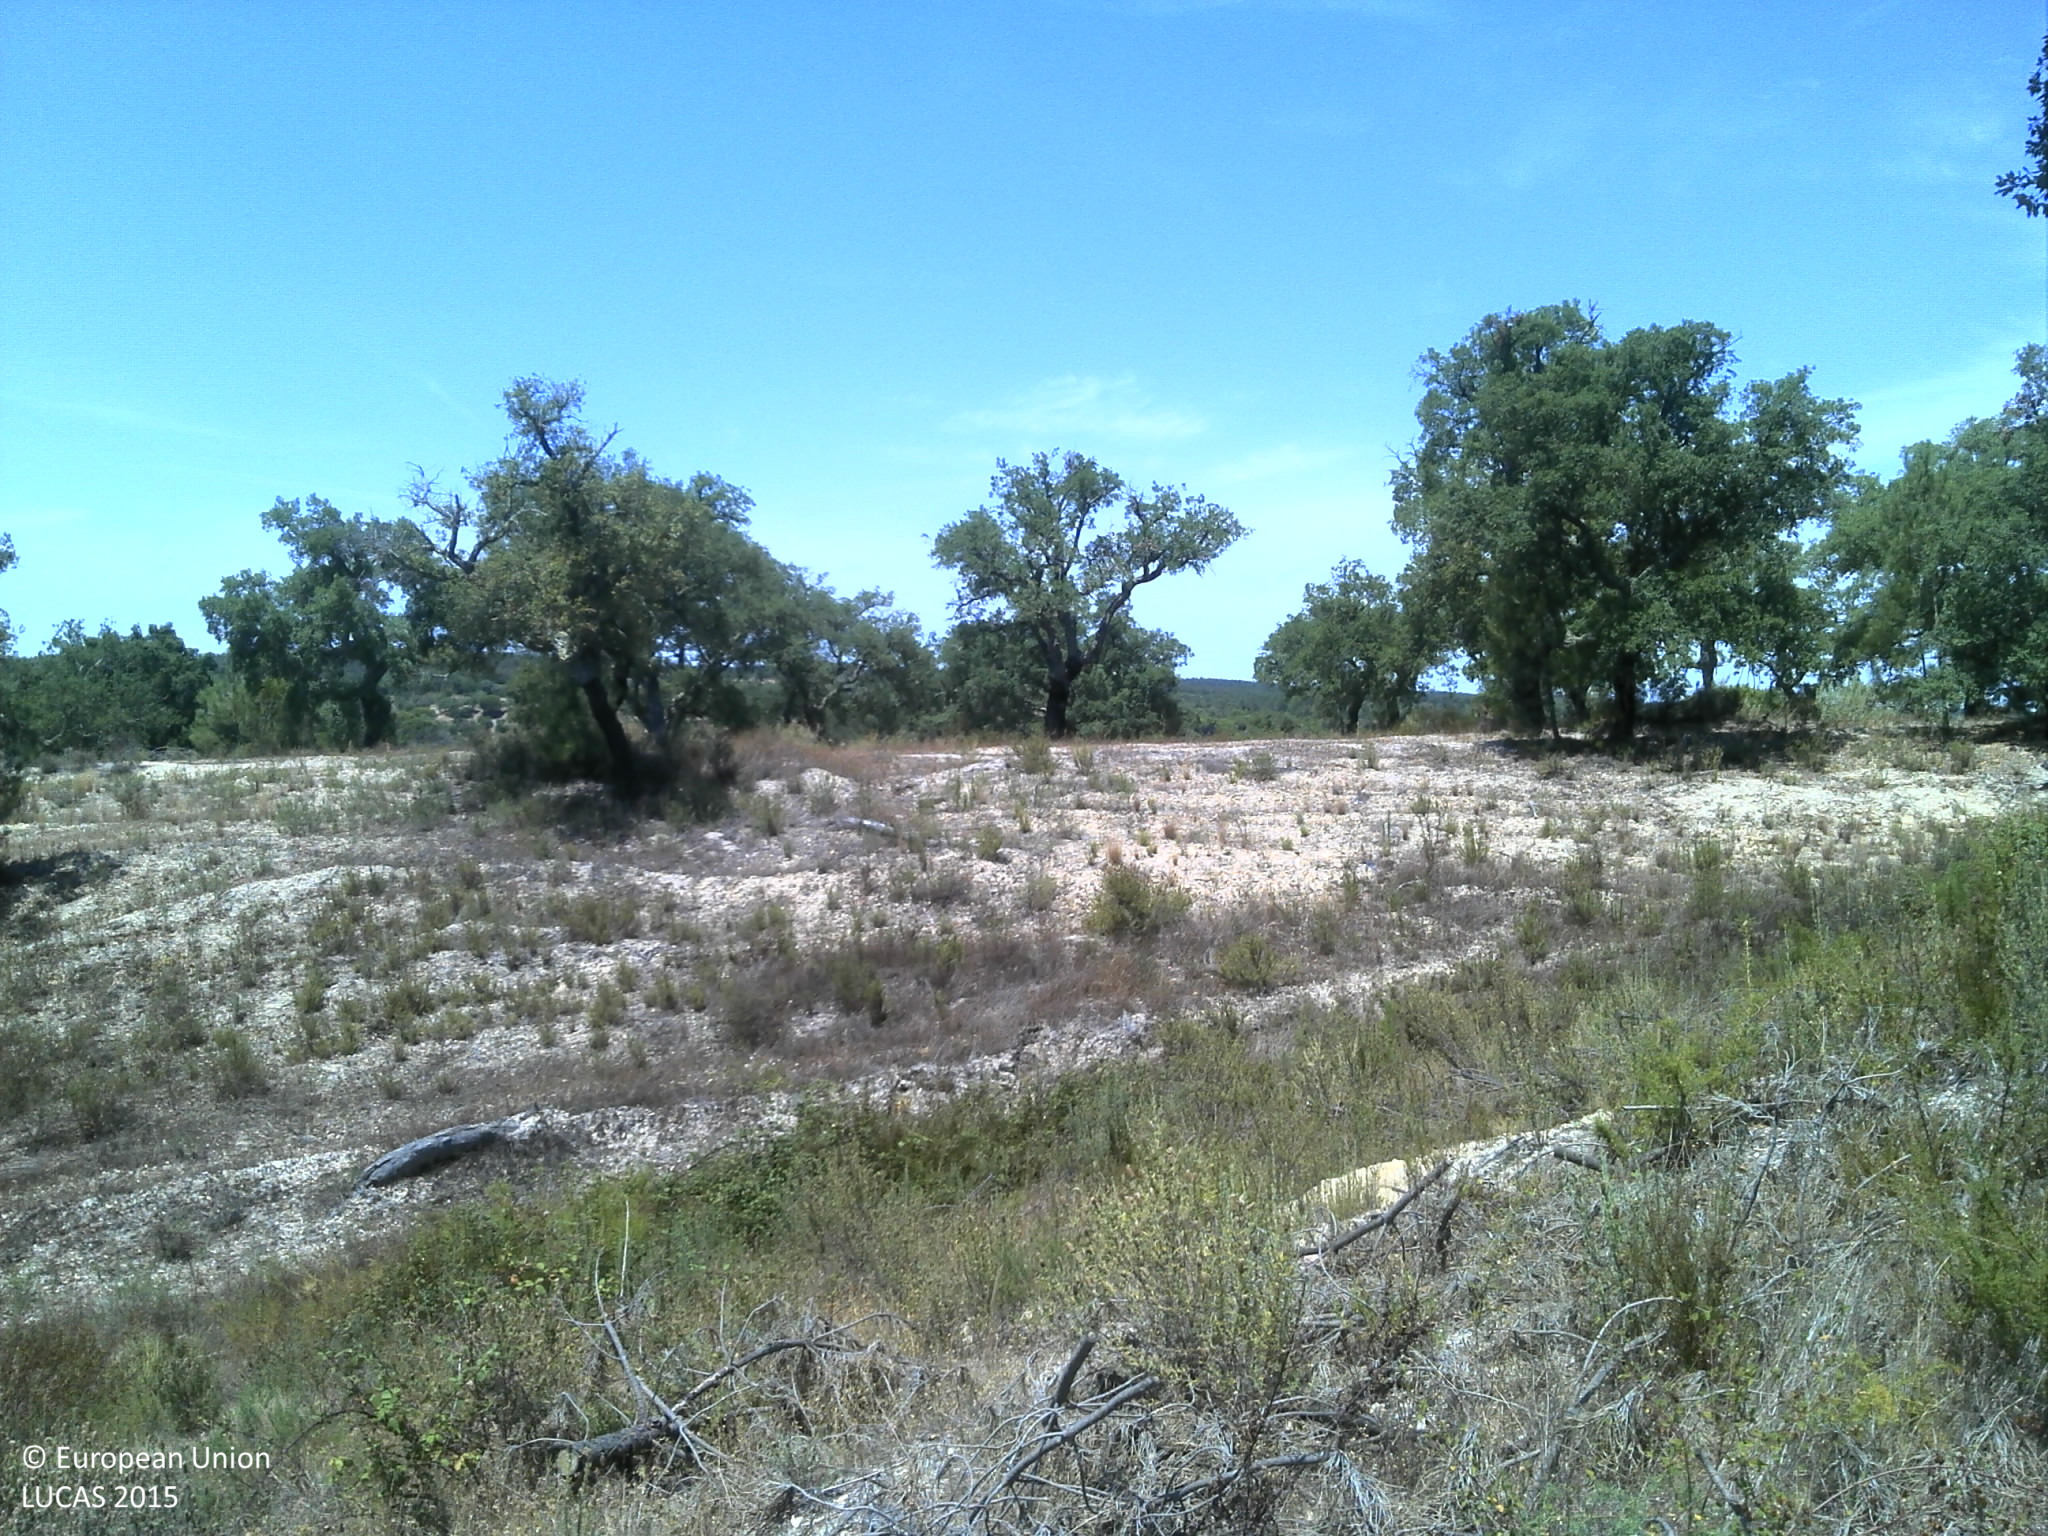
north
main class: Grassland
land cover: Grassland with sparse tree/shrub cover
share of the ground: 25 - 50 %
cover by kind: herbaceous plants 45 %, unconsolidated bare surface 40 %, shrubs 10 %, broadleaved forest trees 5 %
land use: Forestry
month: July
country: PT
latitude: 39.2176
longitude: -8.2801
